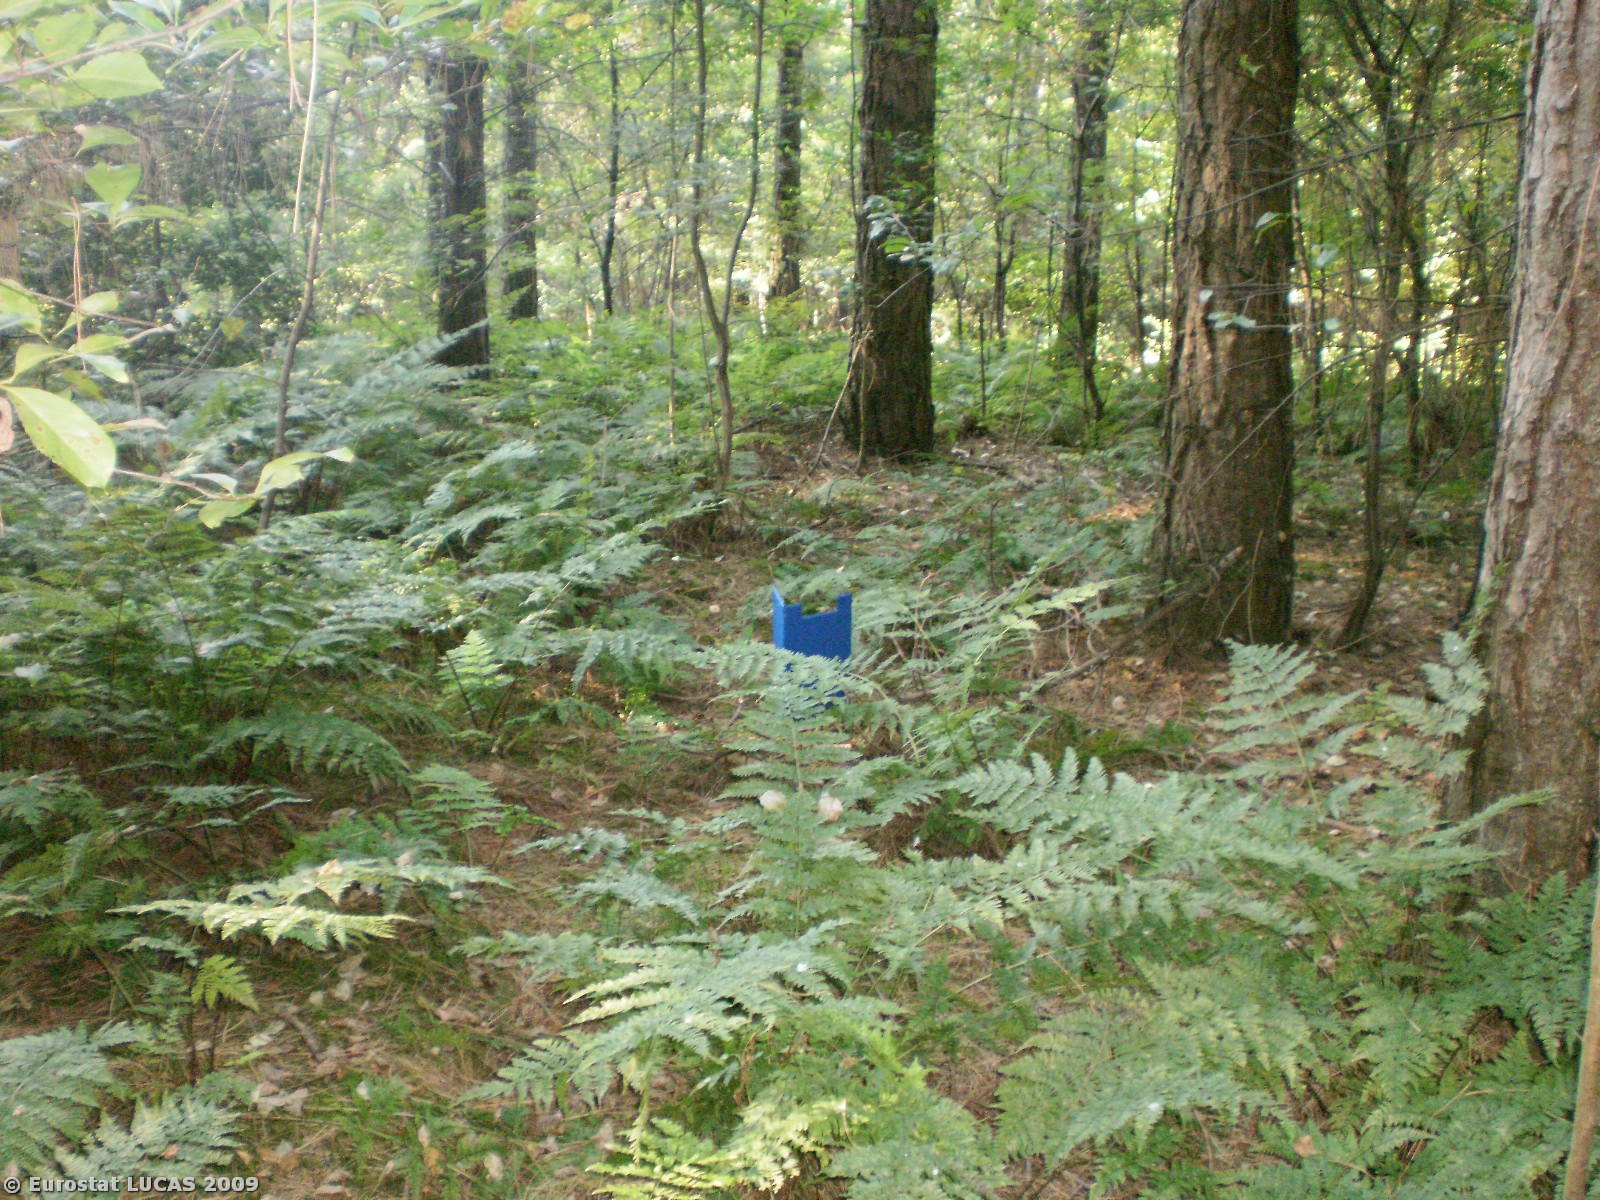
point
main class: Woodland
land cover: Coniferous woodland
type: hemiboreal forest and nemoral coniferous forest and mixed broadleaved-coniferous forest
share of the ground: > 75 %
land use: Forestry
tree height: > 5 m
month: June
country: BE
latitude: 50.9256
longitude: 5.5452
